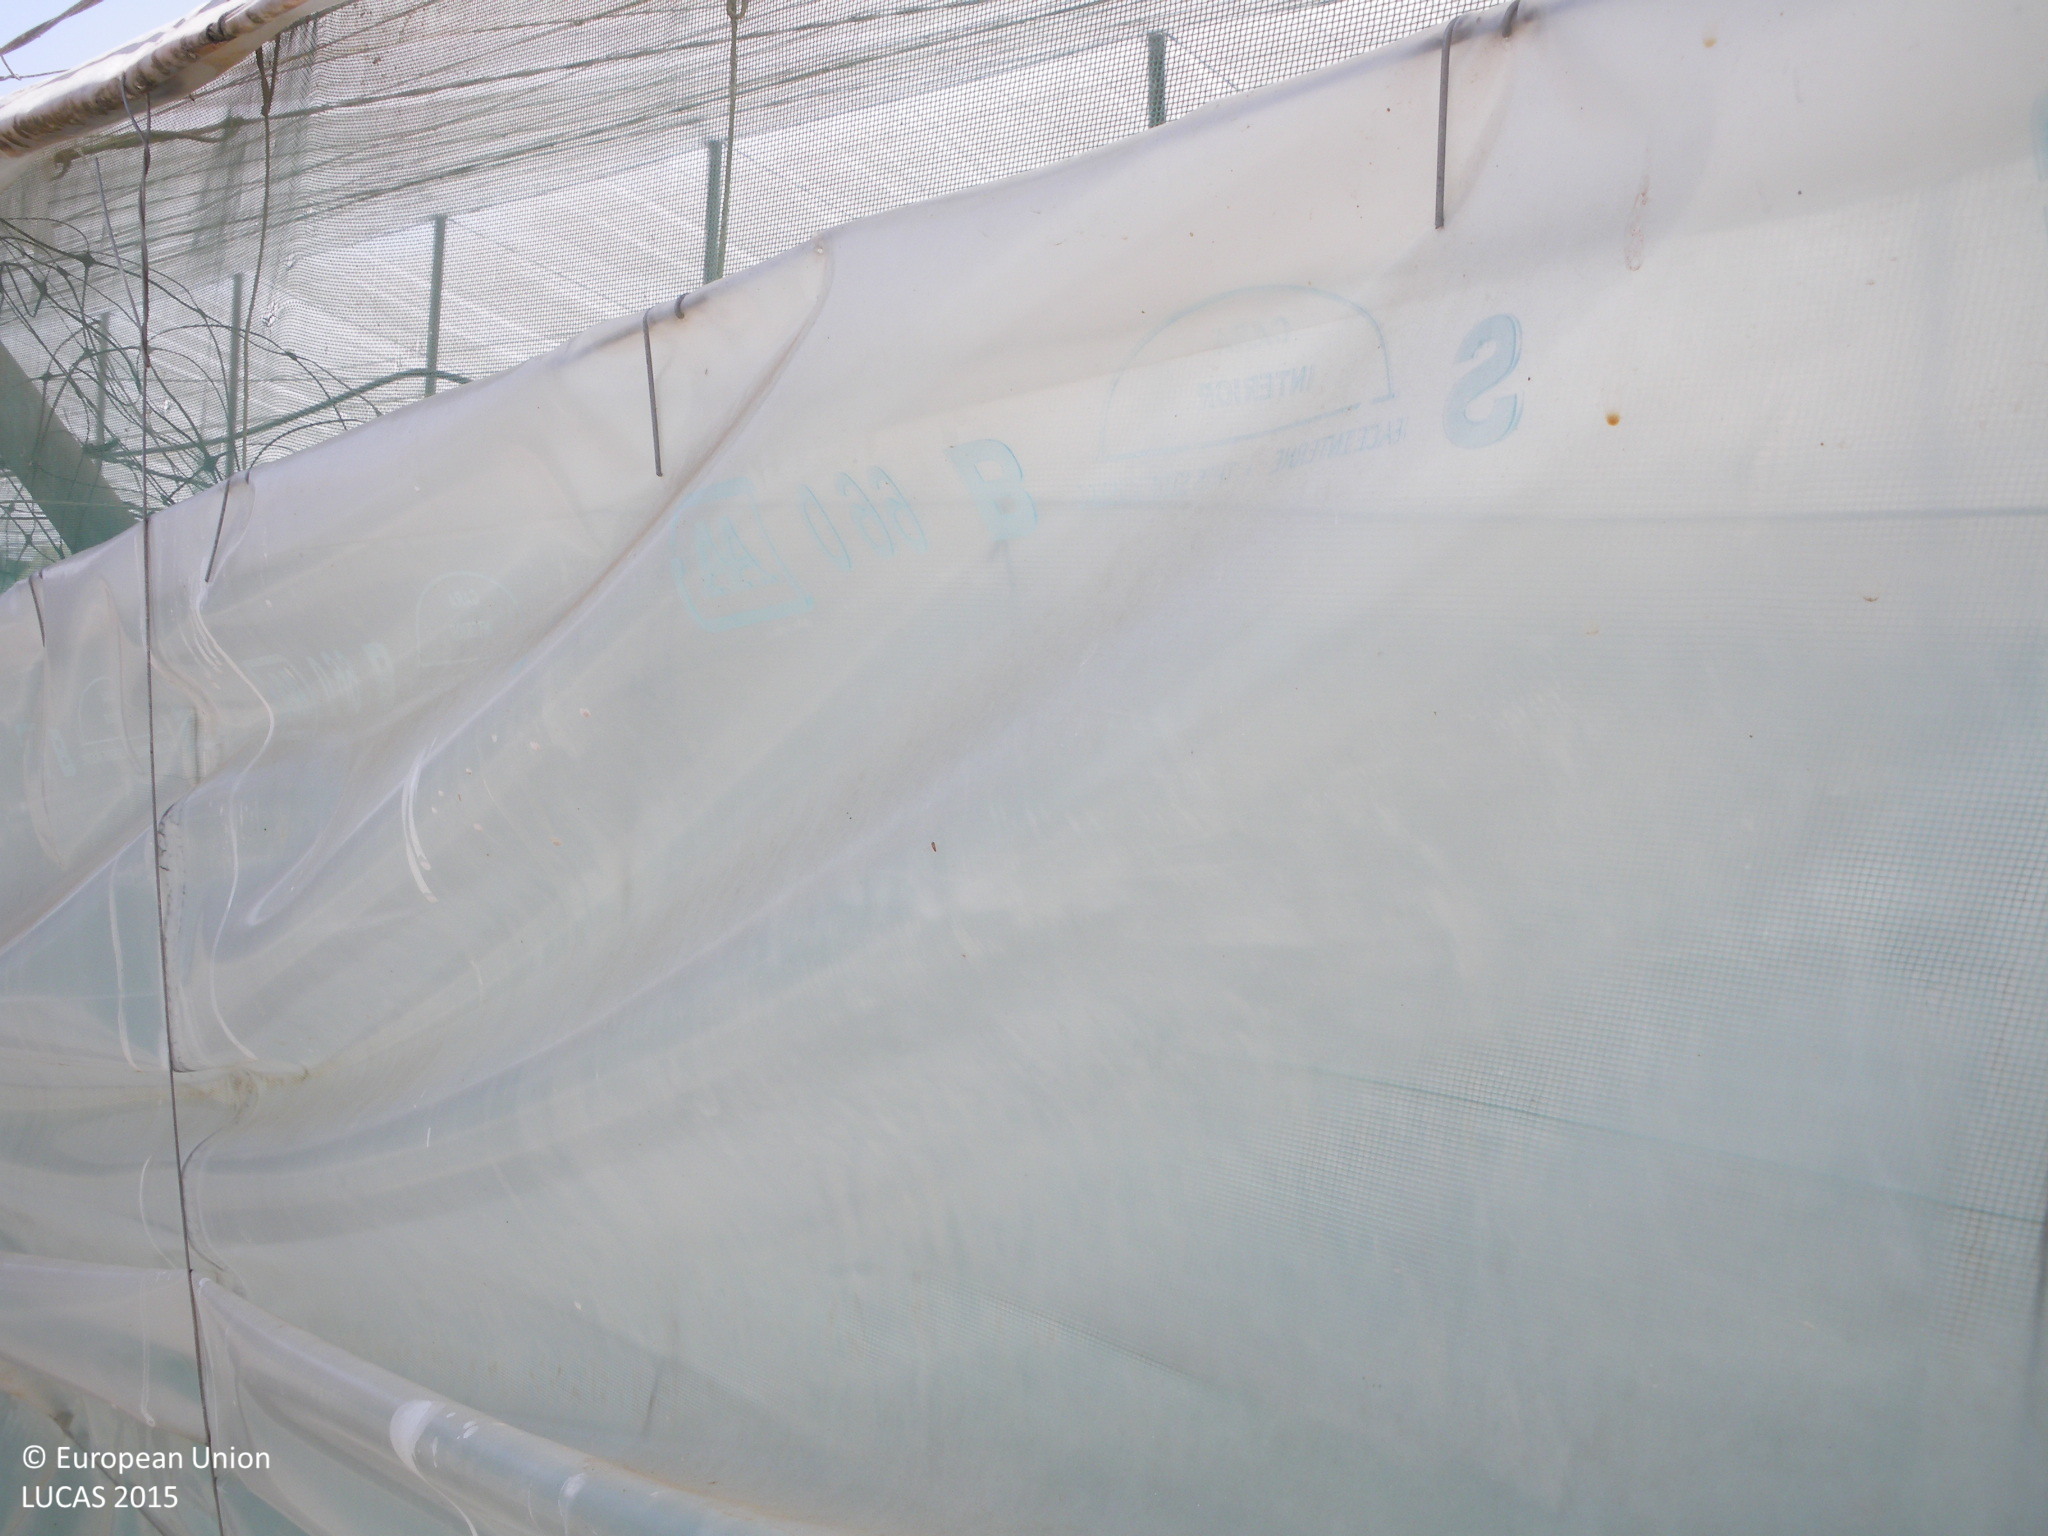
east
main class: Grassland
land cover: Grassland without tree/shrub cover
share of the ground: > 75 %
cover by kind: herbaceous plants 100 %
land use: Residential
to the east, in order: Tracks; Artificial constructions in urban areas
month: June
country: ES
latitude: 36.7553
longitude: -6.4055
